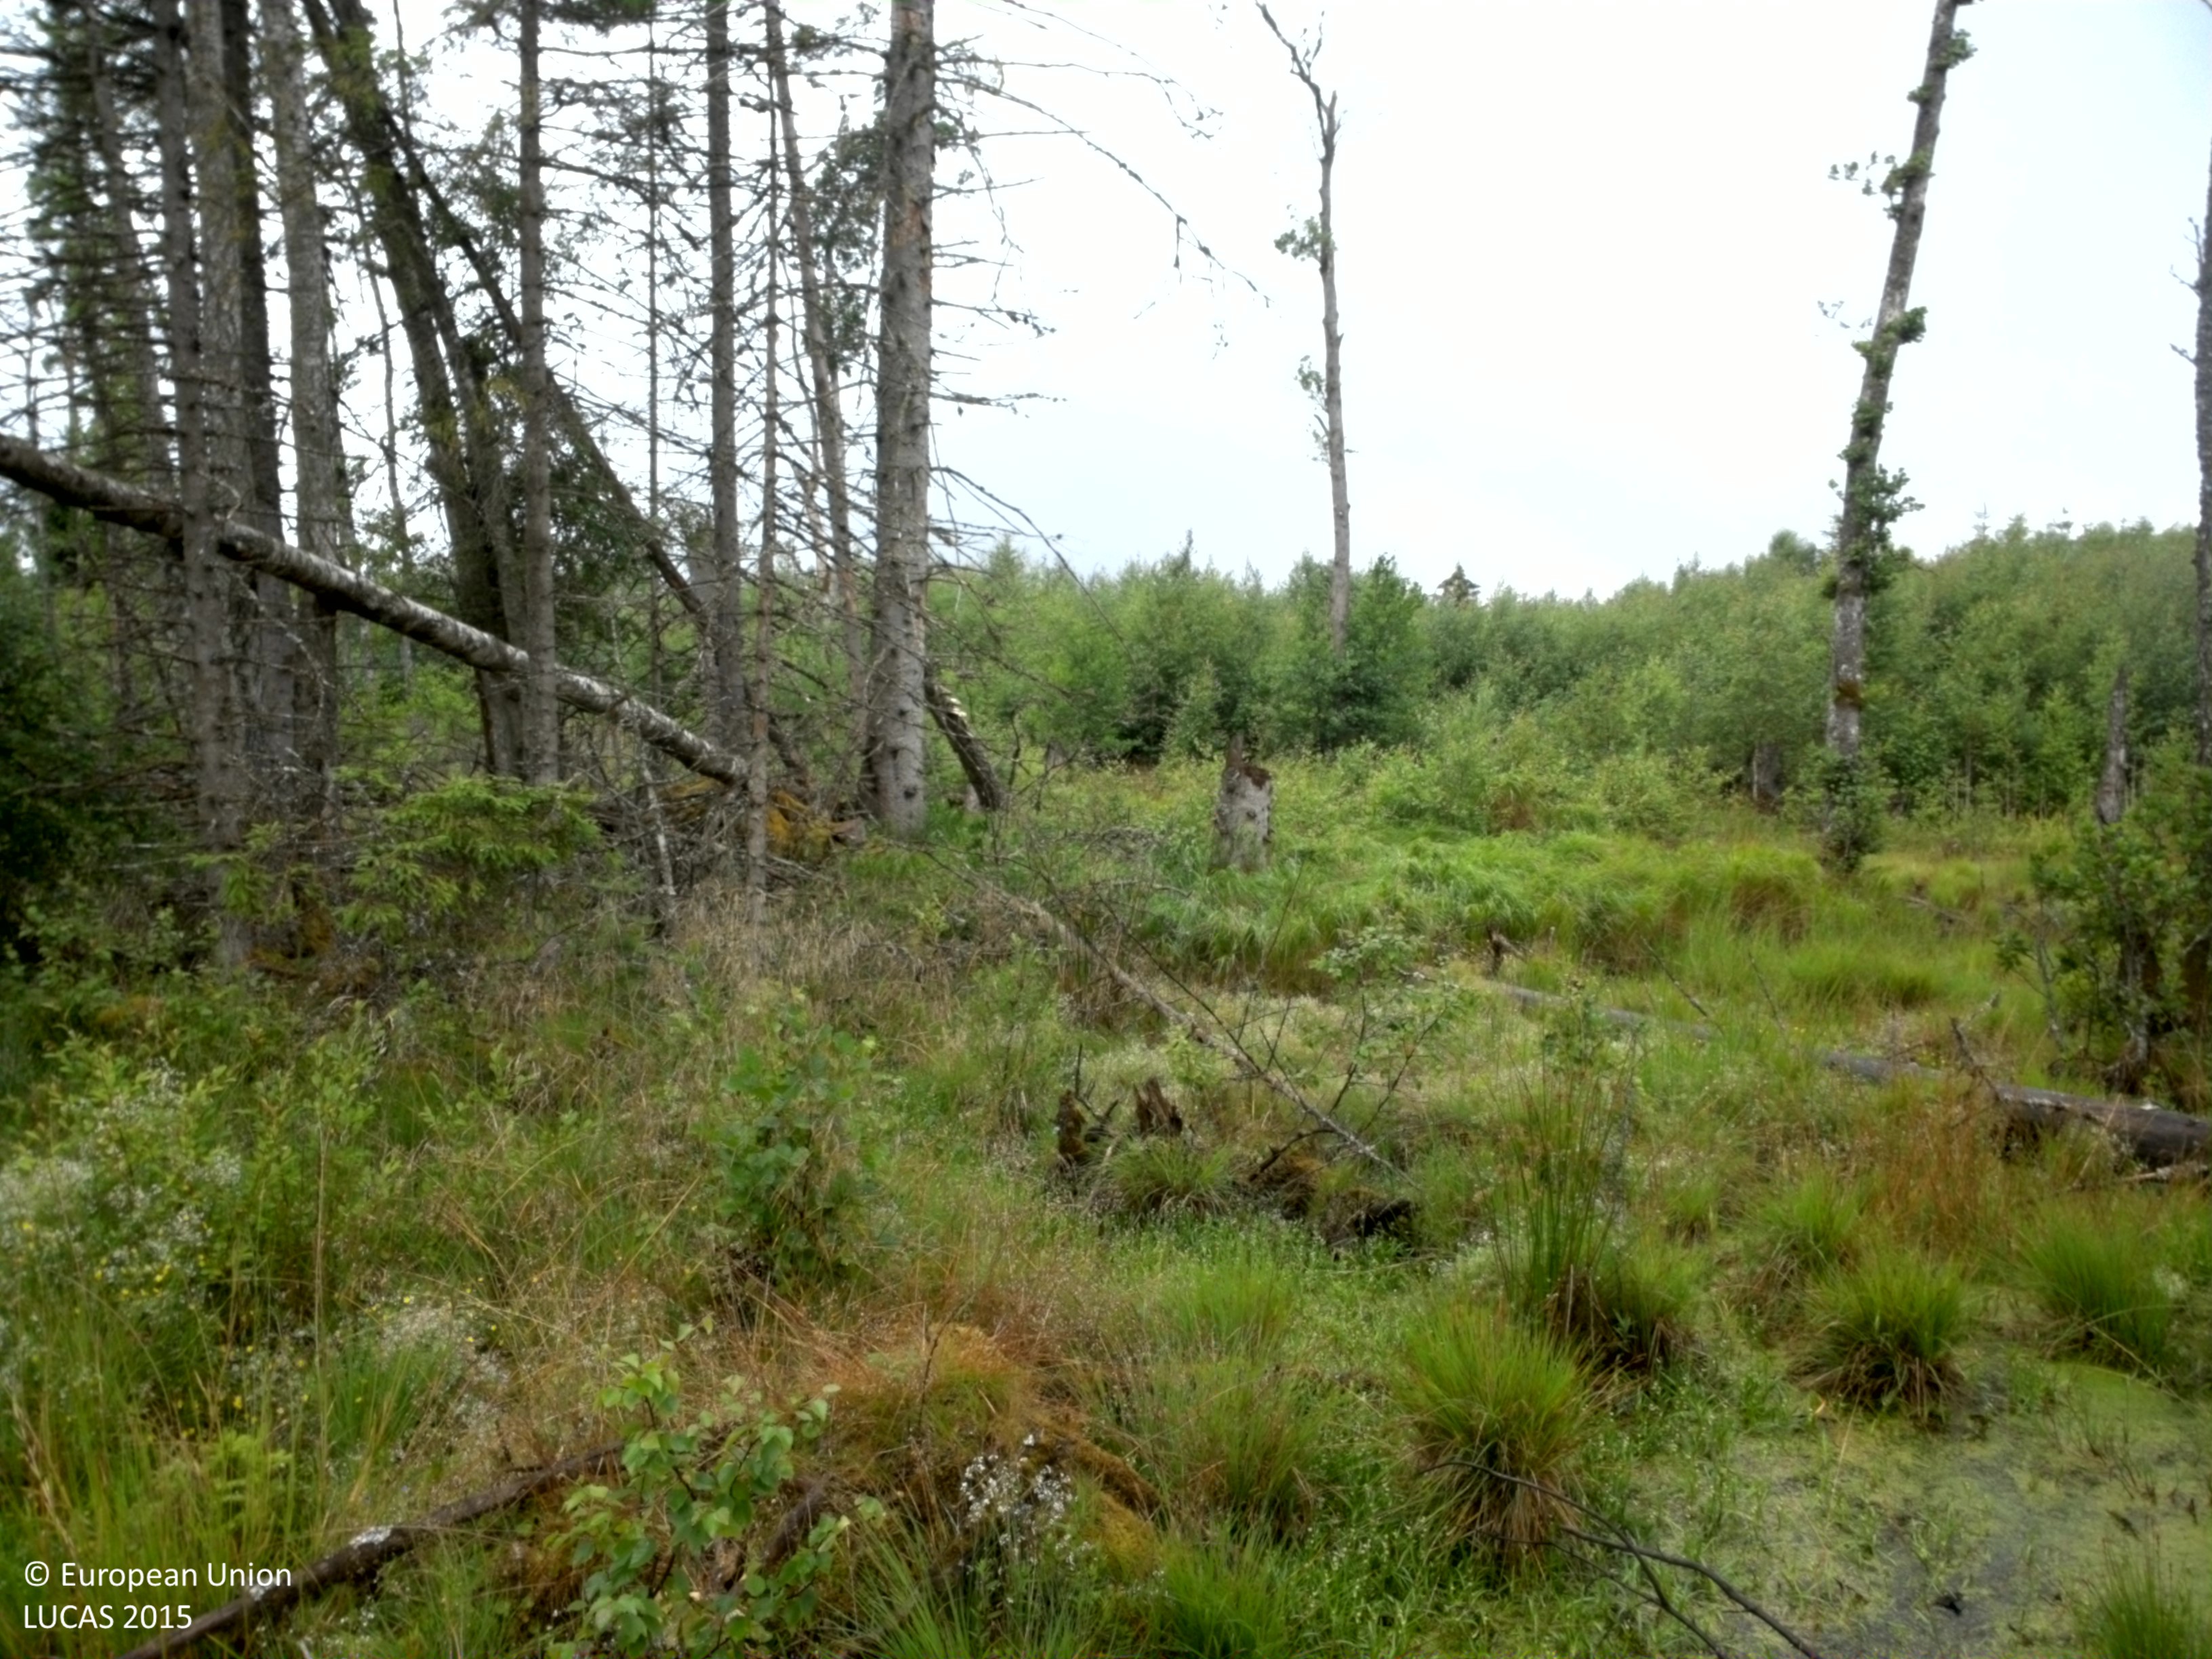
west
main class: Woodland
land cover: Broadleaved woodland
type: hemiboreal forest and nemoral coniferous forest and mixed broadleaved-coniferous forest
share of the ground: > 75 %
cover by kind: broadleaved forest trees 90 %, herbaceous plants 10 %
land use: Forestry
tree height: > 5 m
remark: Clear cut
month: July
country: SE
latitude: 58.3037
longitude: 13.3559
